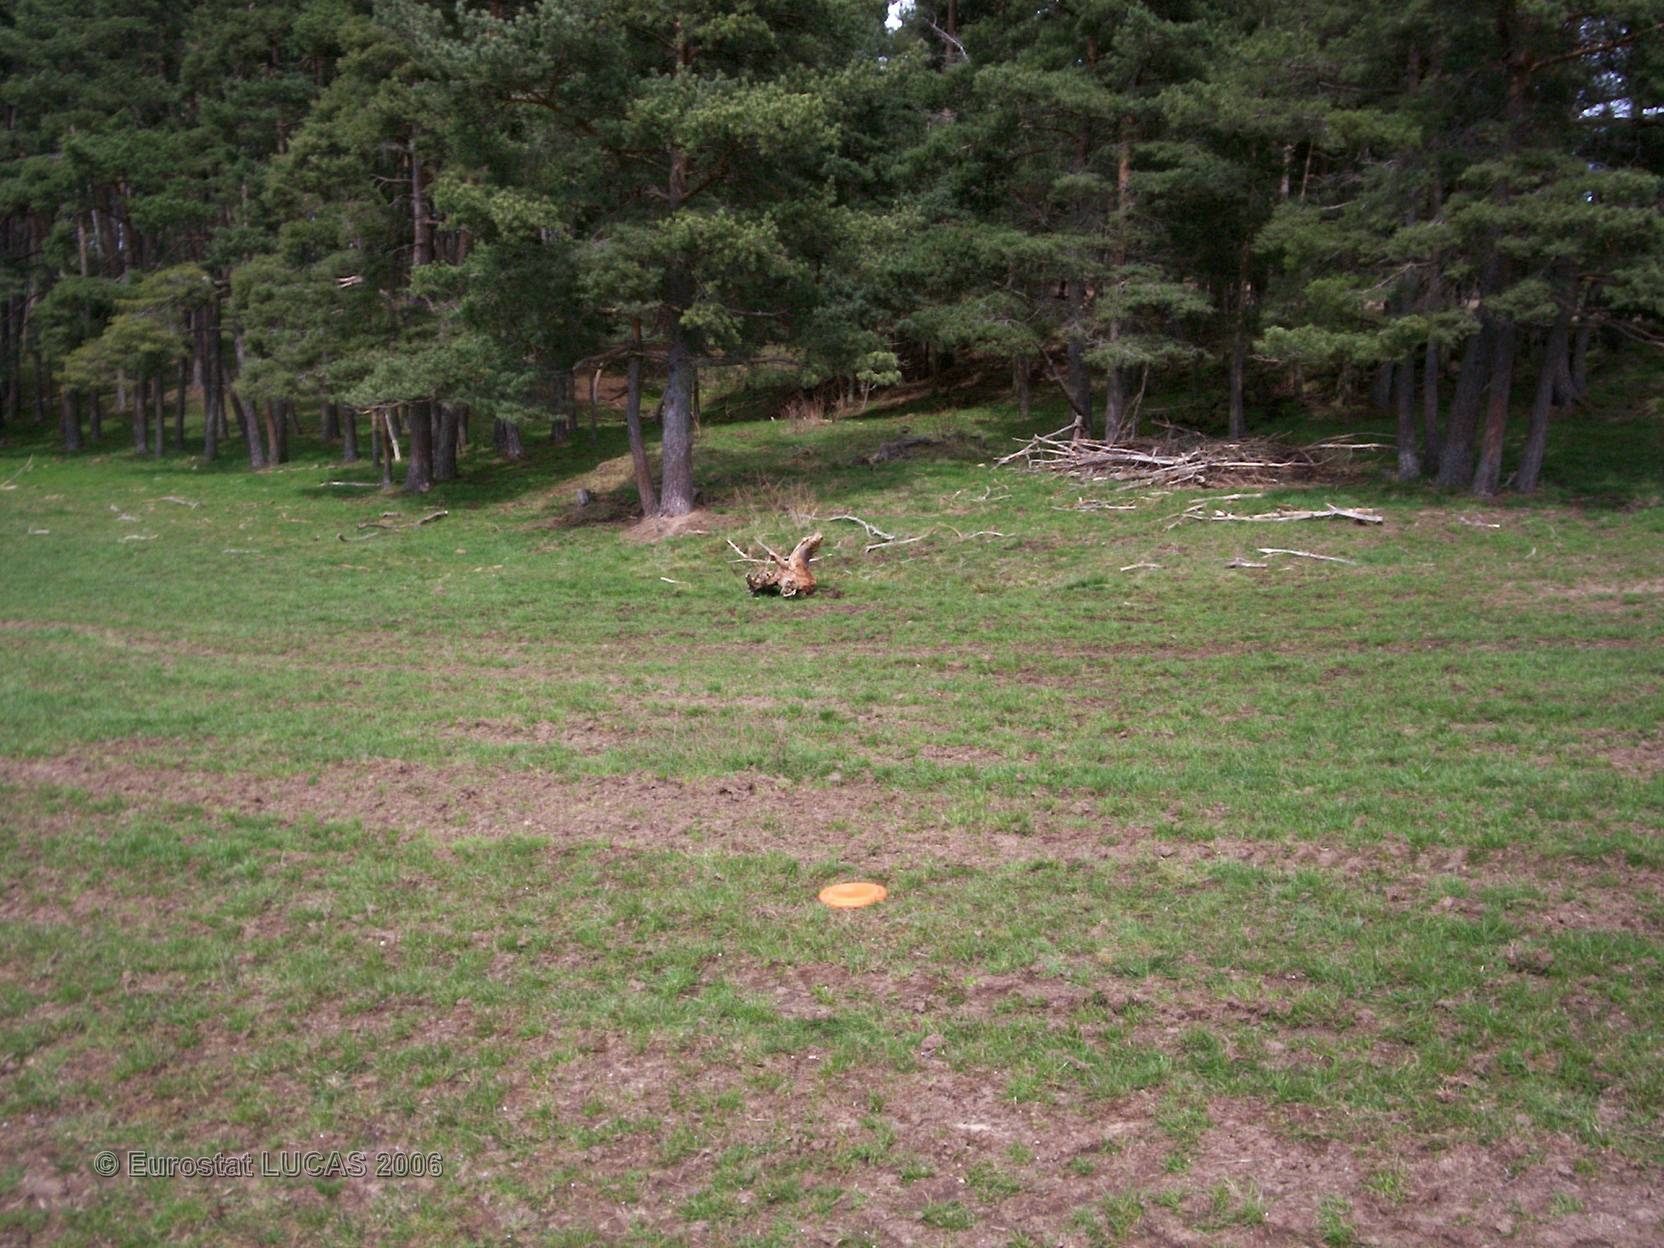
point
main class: Grassland
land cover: Grassland without tree/shrub cover
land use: Agriculture (excluding fallow land and kitchen gardens)
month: April
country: FR
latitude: 44.8206
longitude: 3.2883
